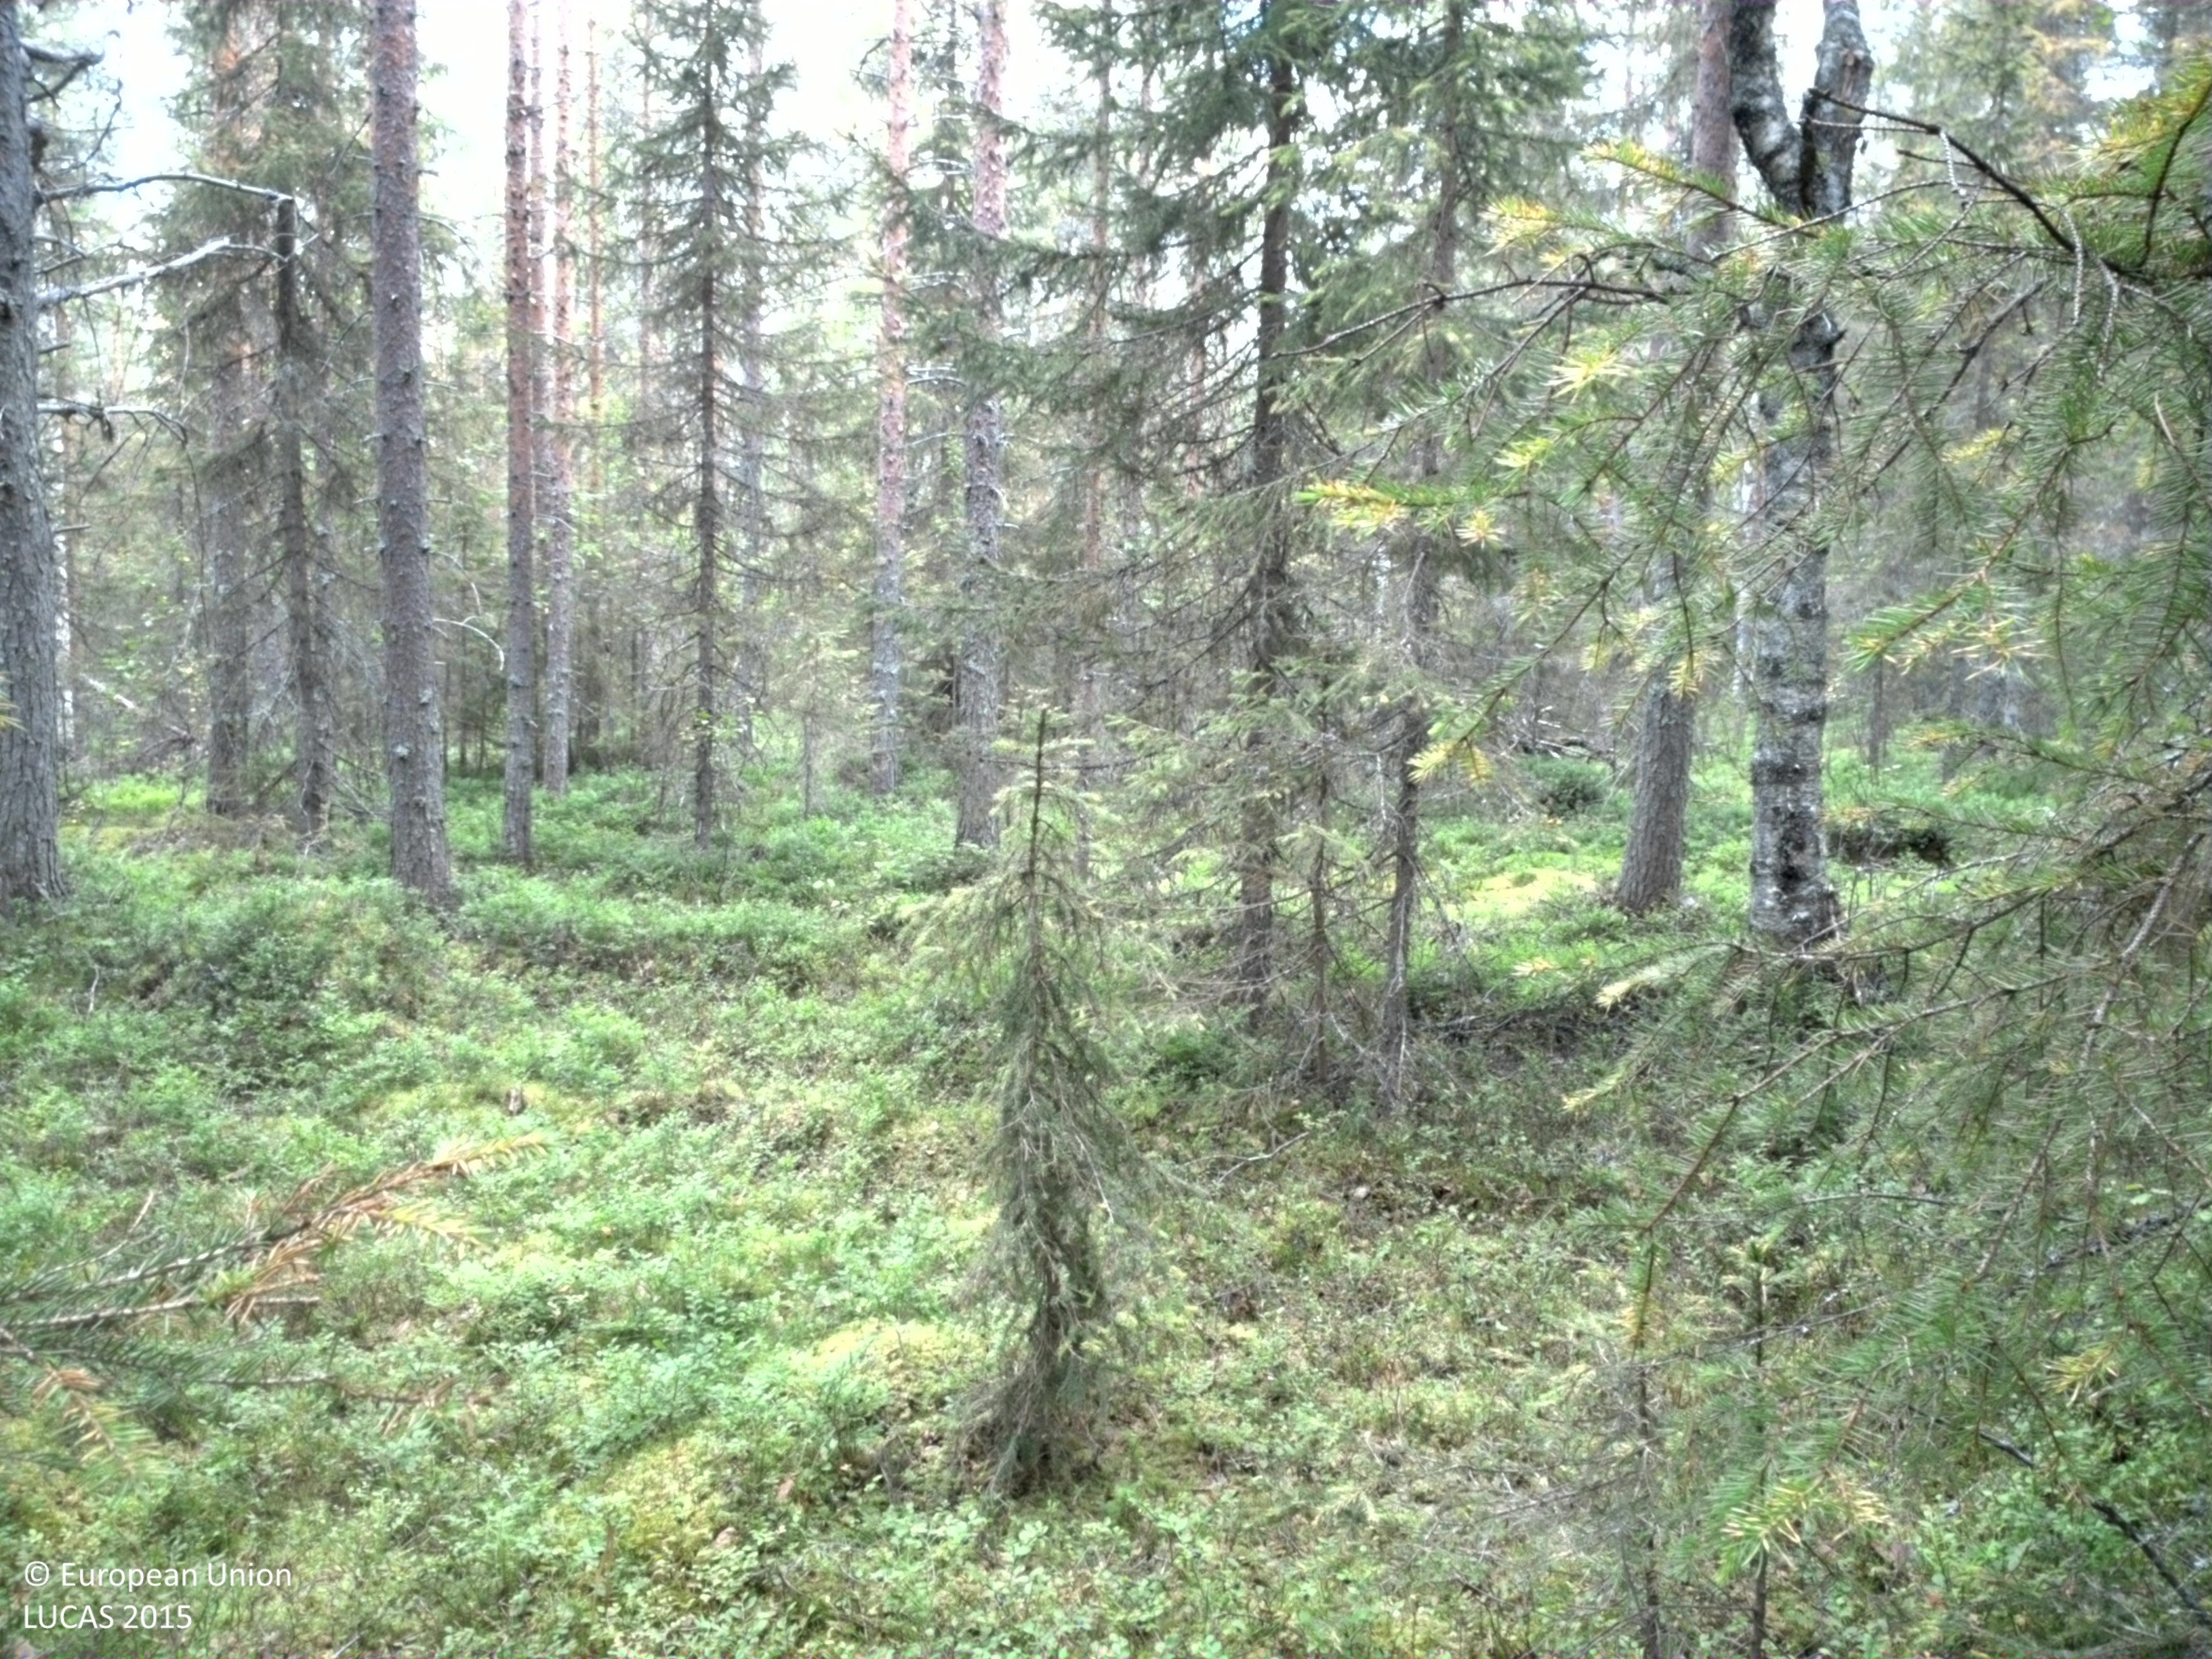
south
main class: Woodland
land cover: Other coniferous woodland
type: boreal forest
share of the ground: 25 - 50 %
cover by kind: shrubs 60 %, coniferous forest trees 40 %
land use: Forestry
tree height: > 5 m
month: August
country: SE
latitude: 66.2100
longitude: 22.7976
